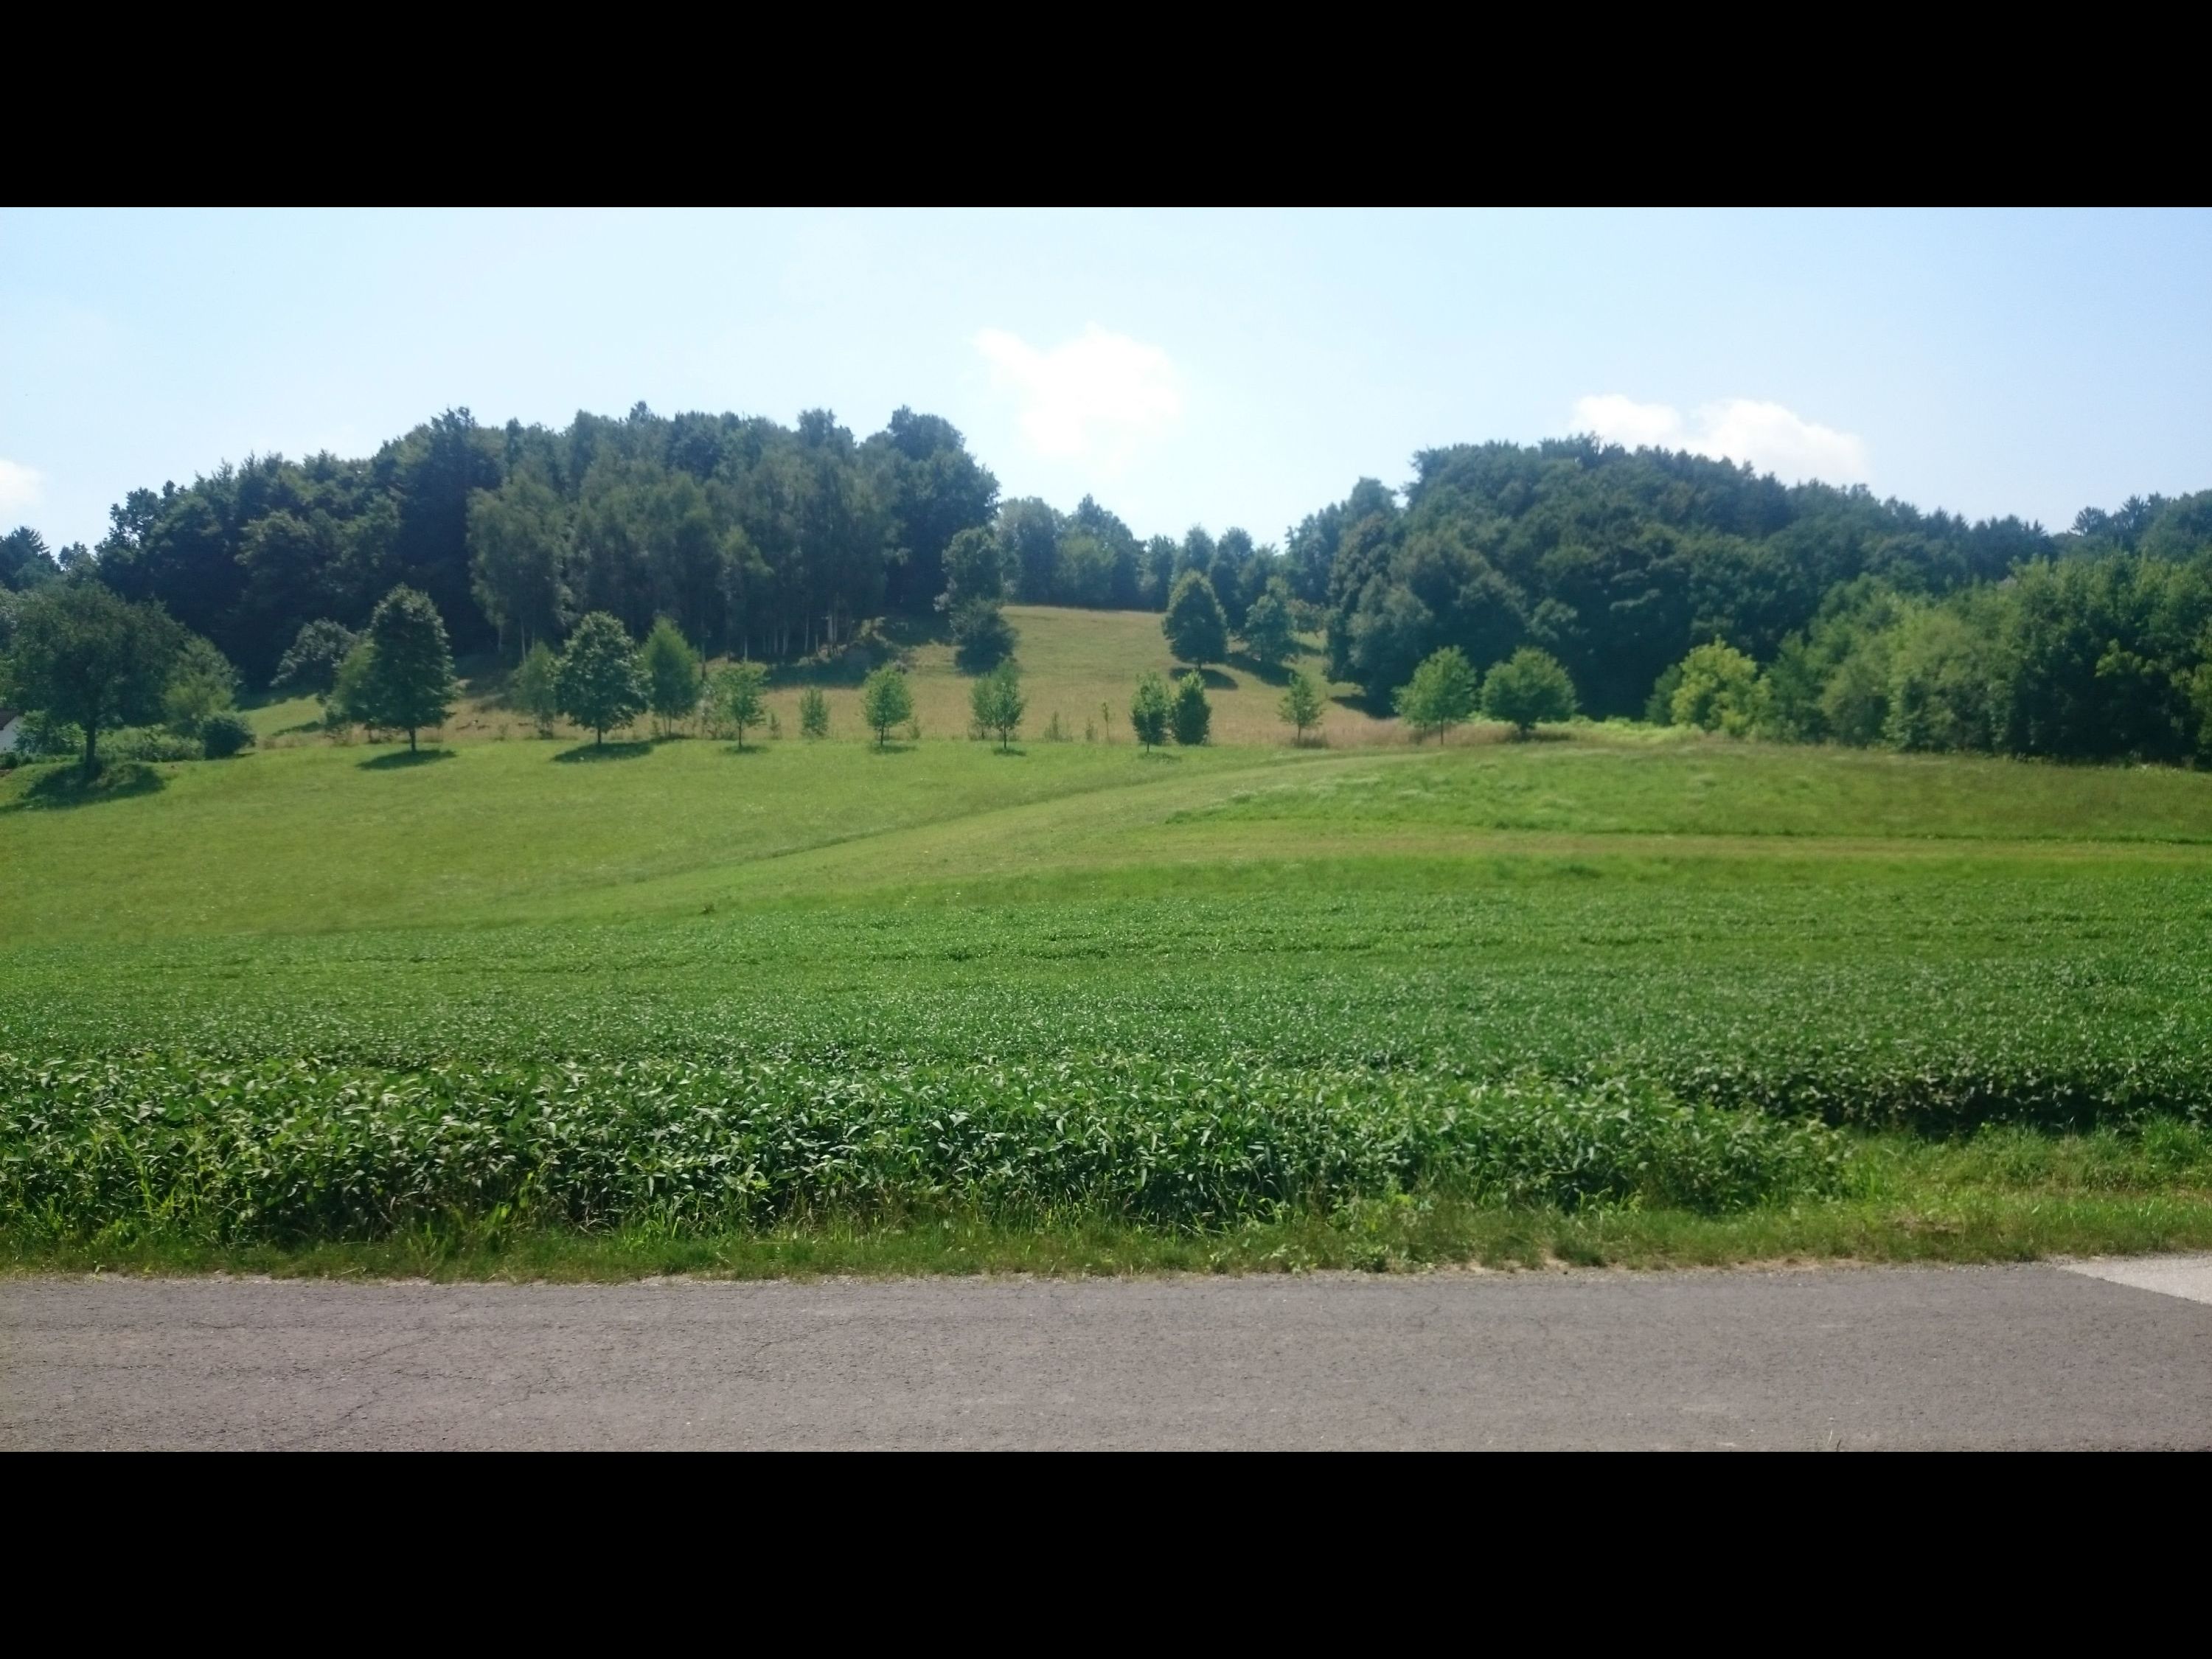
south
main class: Cropland
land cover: Clovers
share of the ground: > 75 %
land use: Agriculture (excluding fallow land and kitchen gardens)
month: July
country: AT
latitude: 47.0082
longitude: 16.0912
